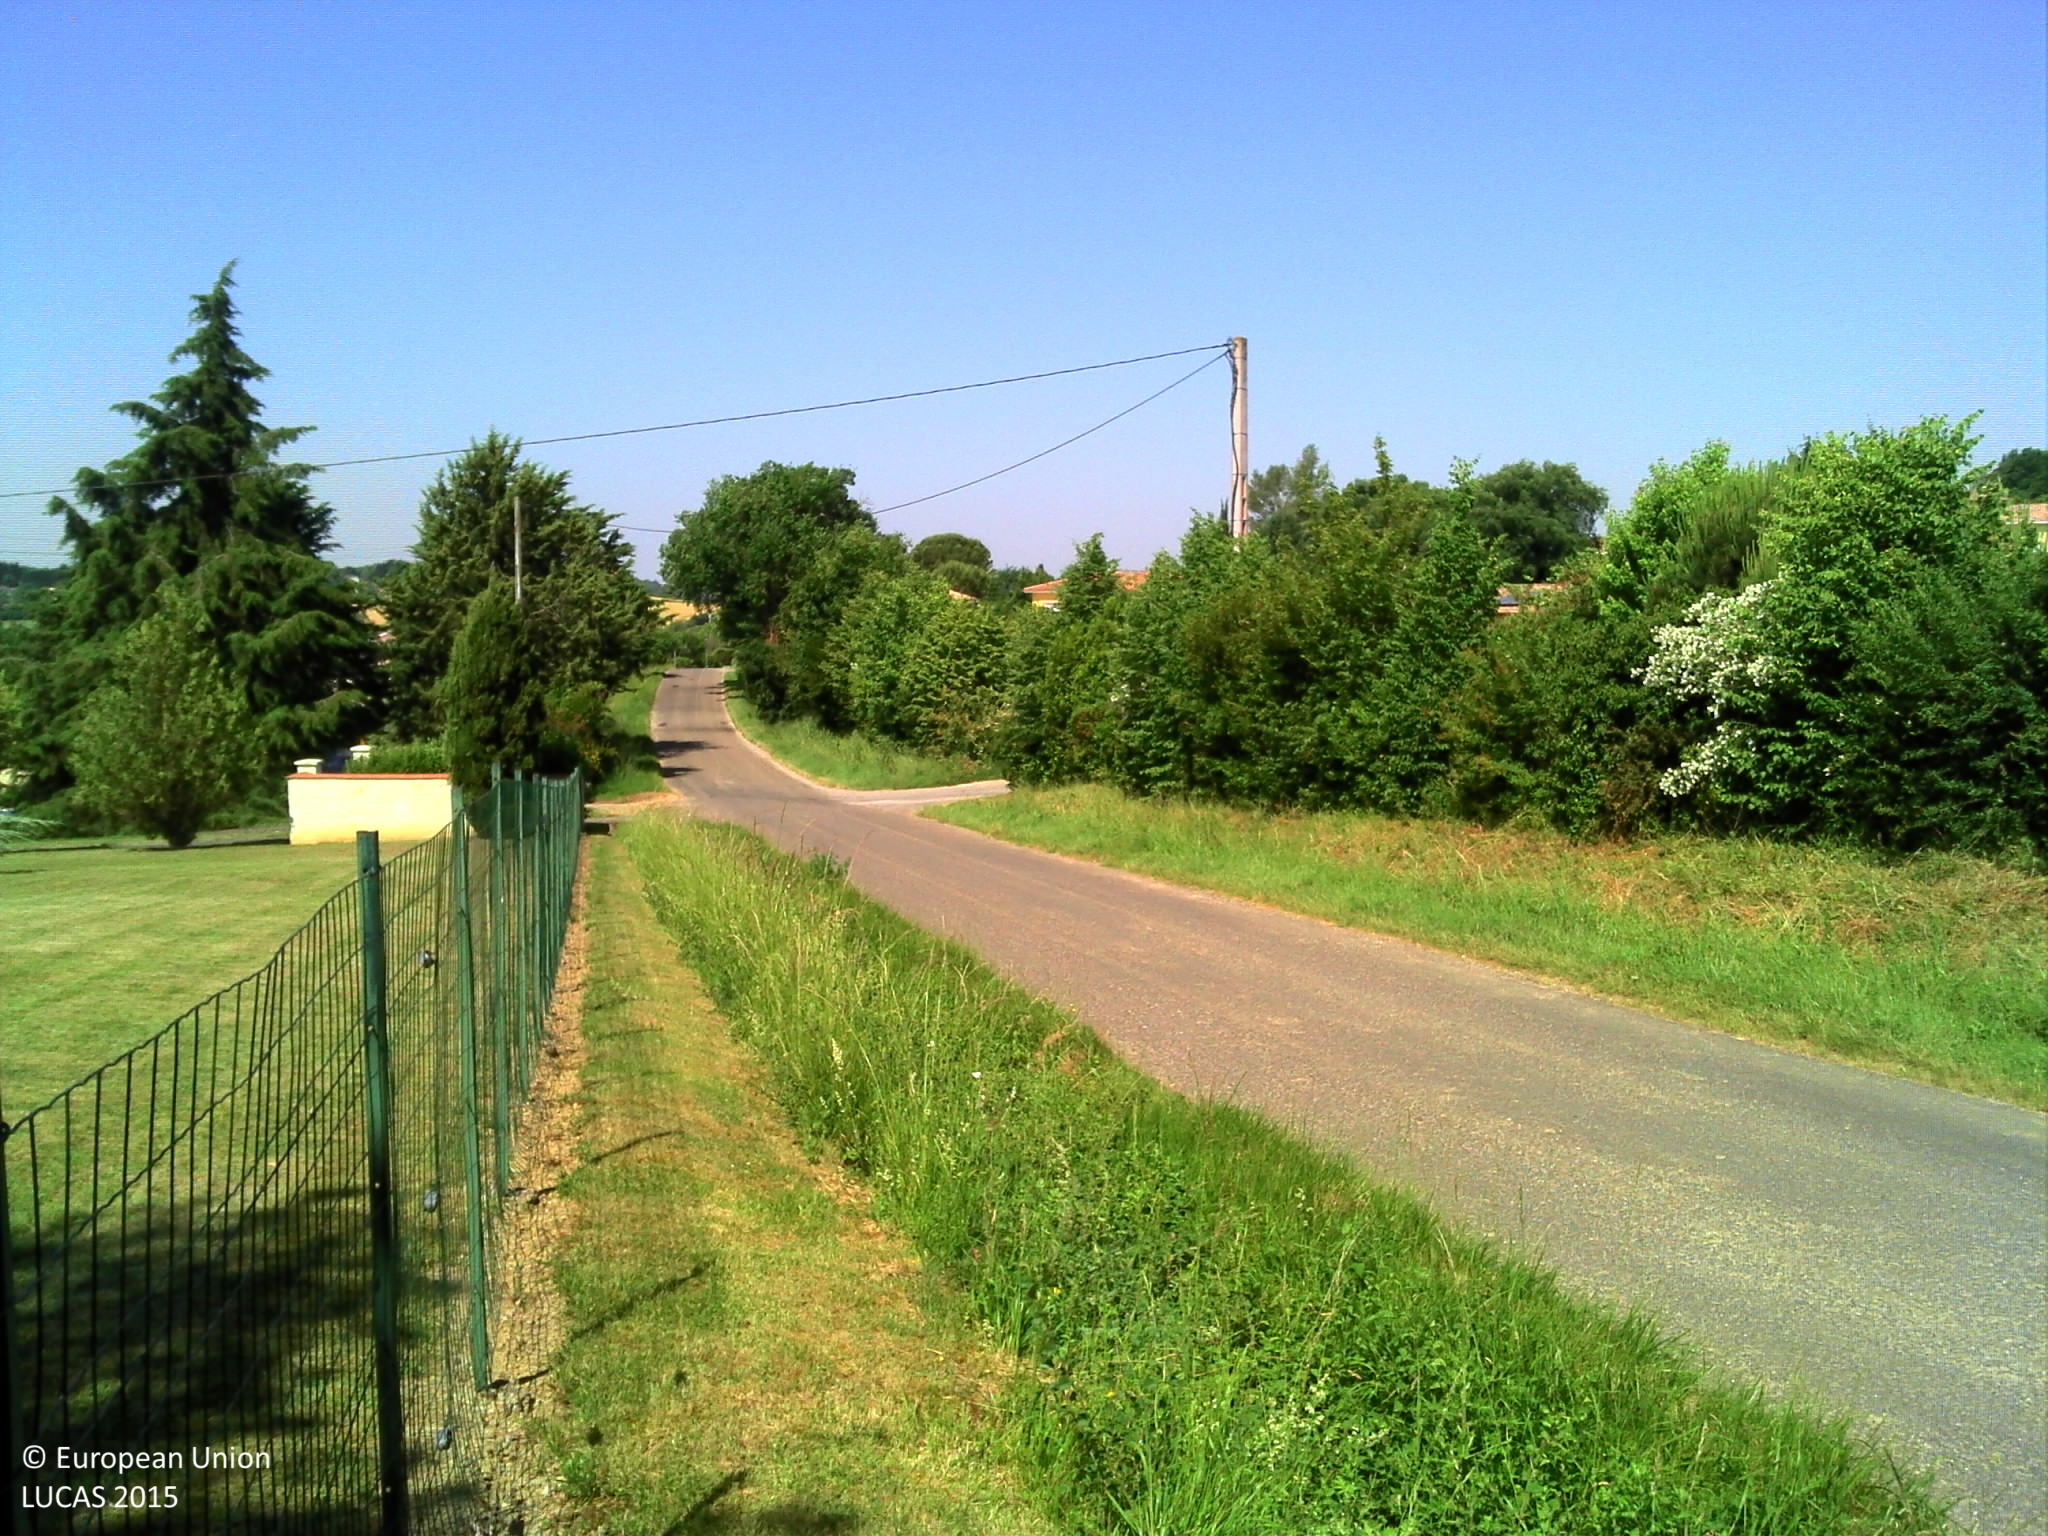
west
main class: Grassland
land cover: Grassland with sparse tree/shrub cover
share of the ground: > 75 %
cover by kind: herbaceous plants 95 %, broadleaved forest trees 5 %
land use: Residential
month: June
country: FR
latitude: 43.6586
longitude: 0.6858
